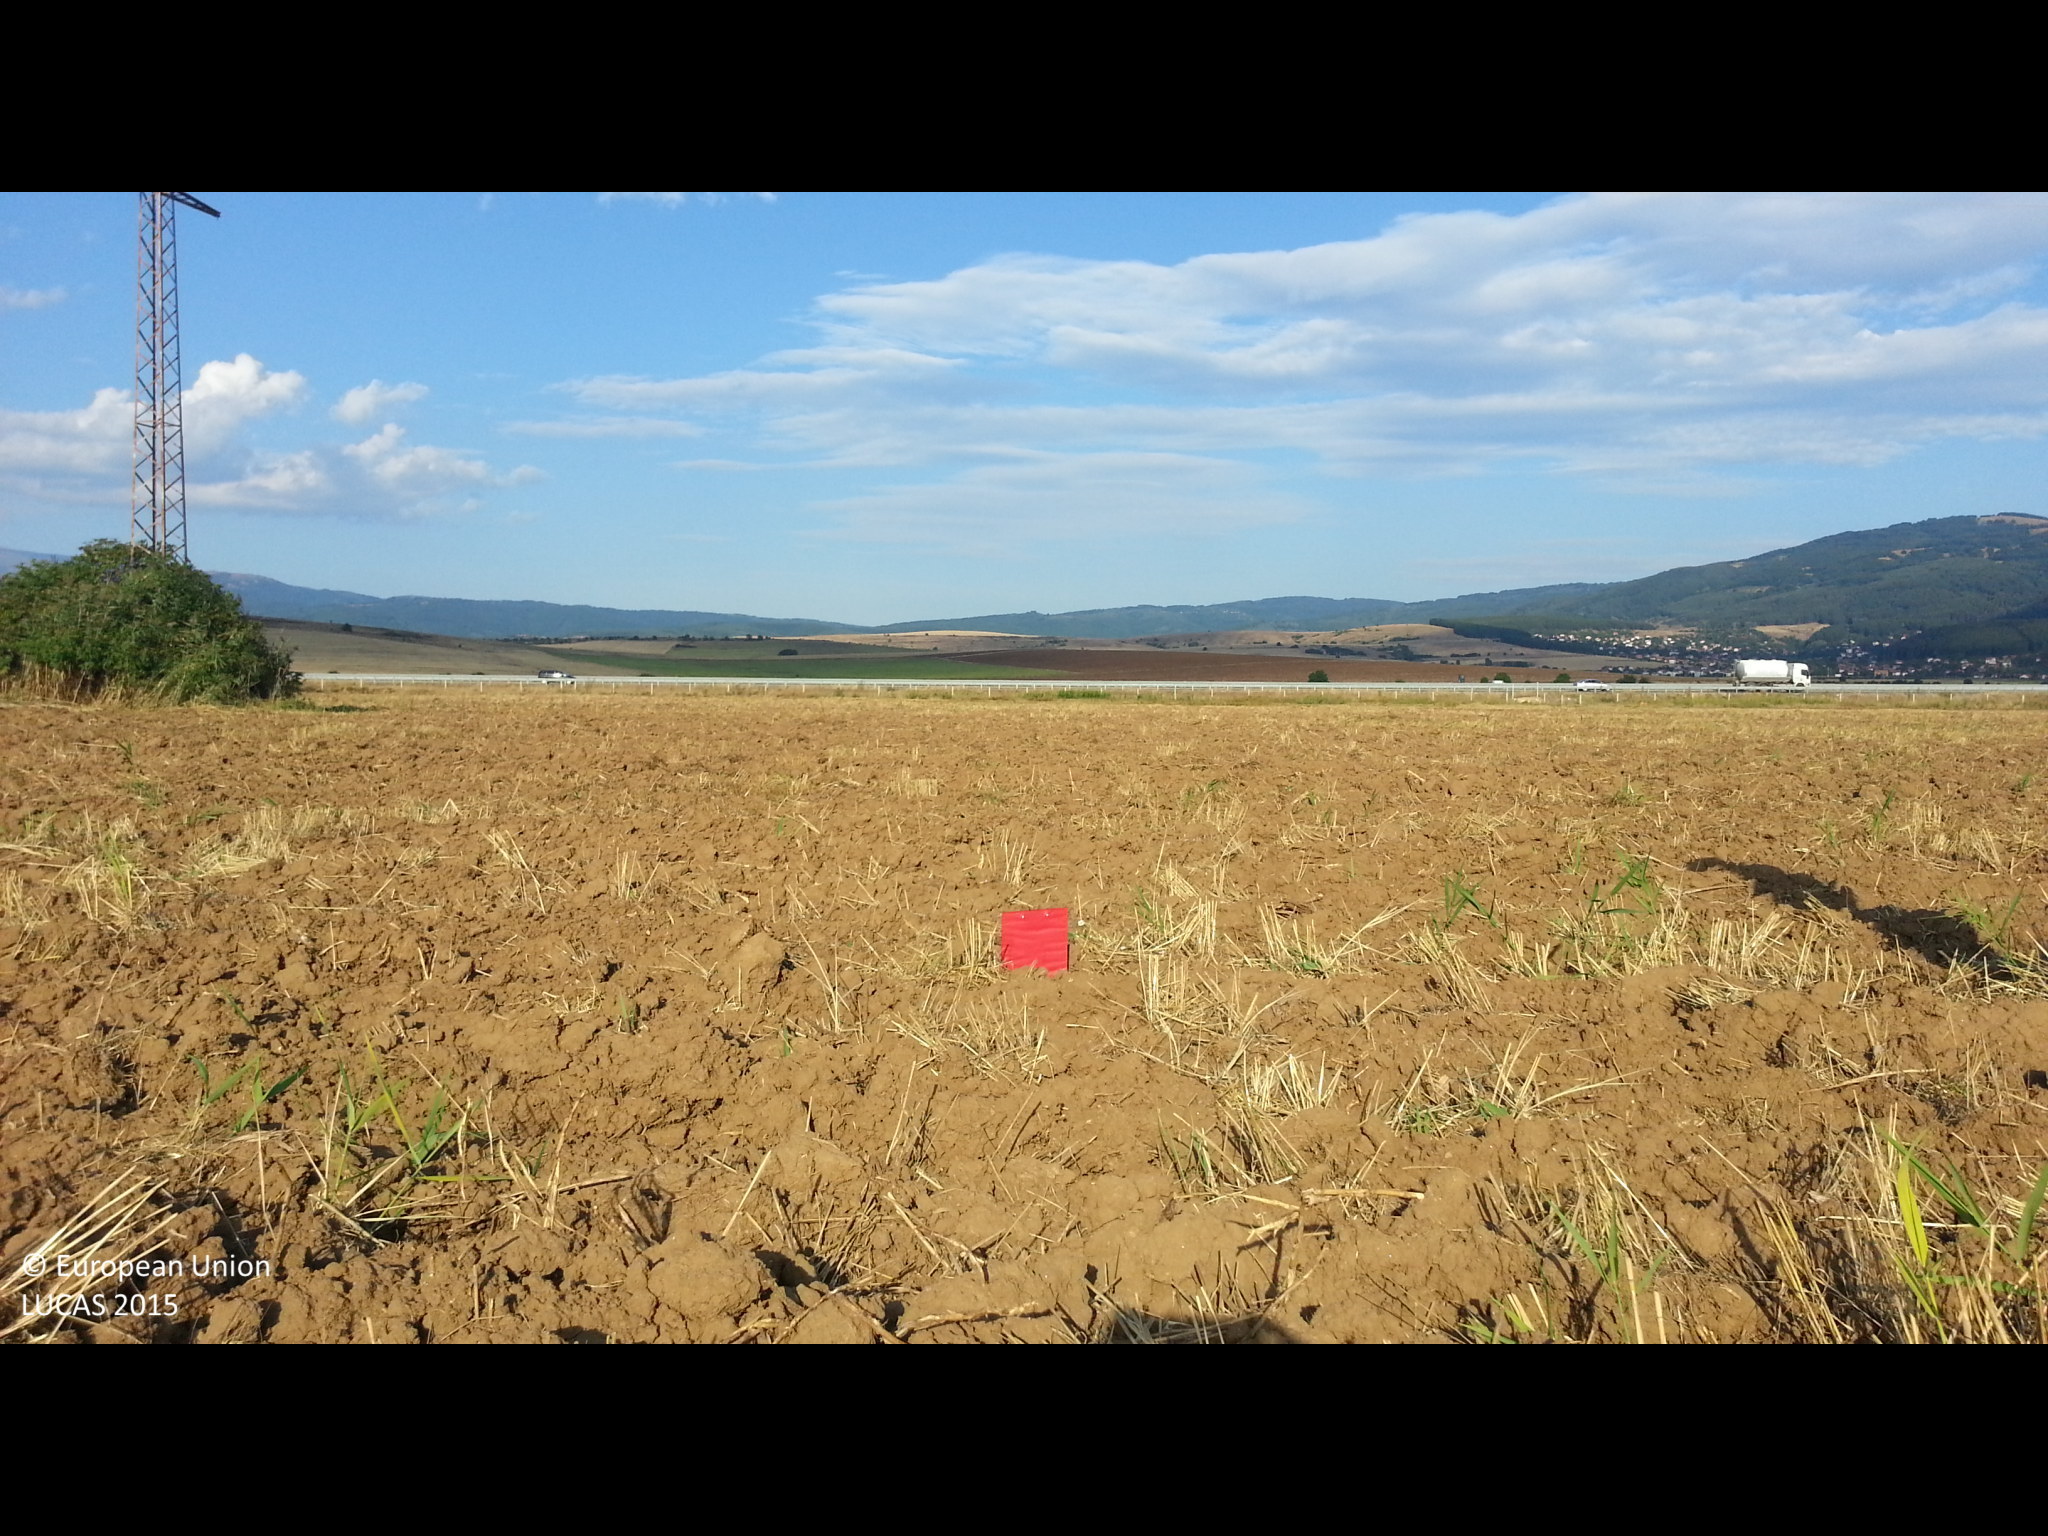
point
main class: Cropland
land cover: Common wheat
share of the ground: < 10 %
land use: Agriculture (excluding fallow land and kitchen gardens)
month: August
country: BG
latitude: 42.4181
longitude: 23.1171
